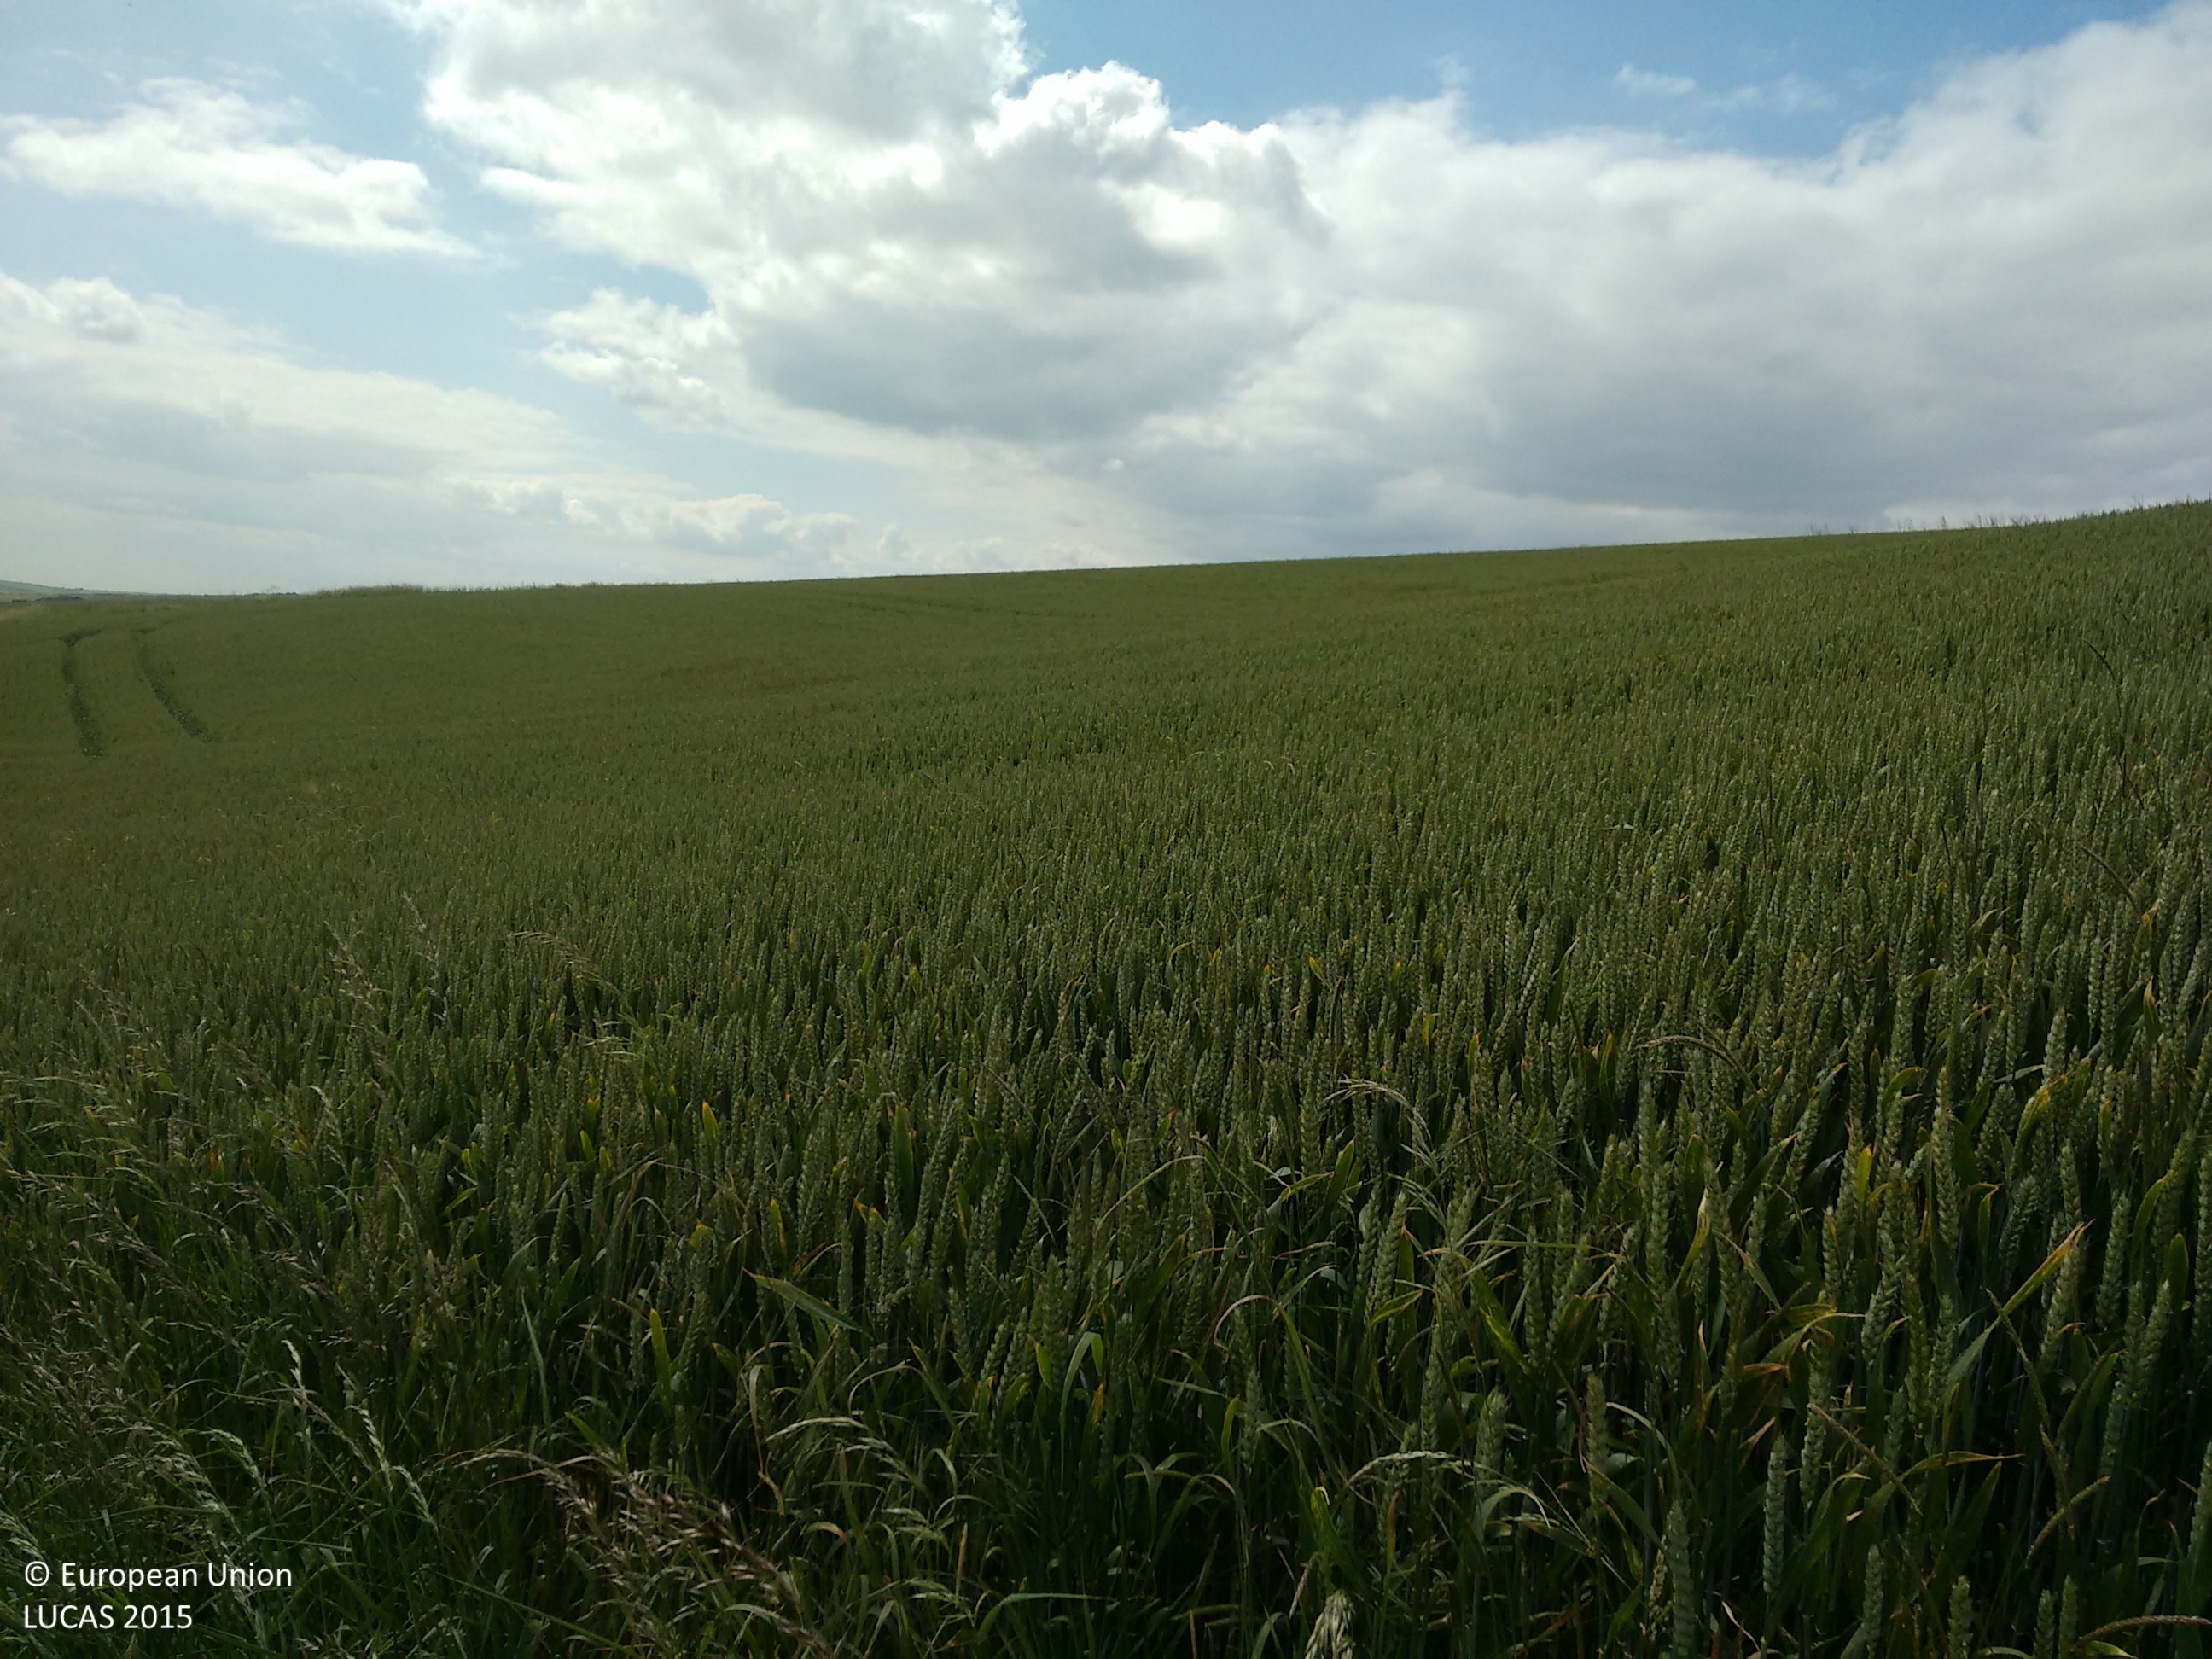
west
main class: Cropland
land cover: Common wheat
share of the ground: > 75 %
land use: Agriculture (excluding fallow land and kitchen gardens)
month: June
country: GB
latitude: 50.8933
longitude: -0.1138
